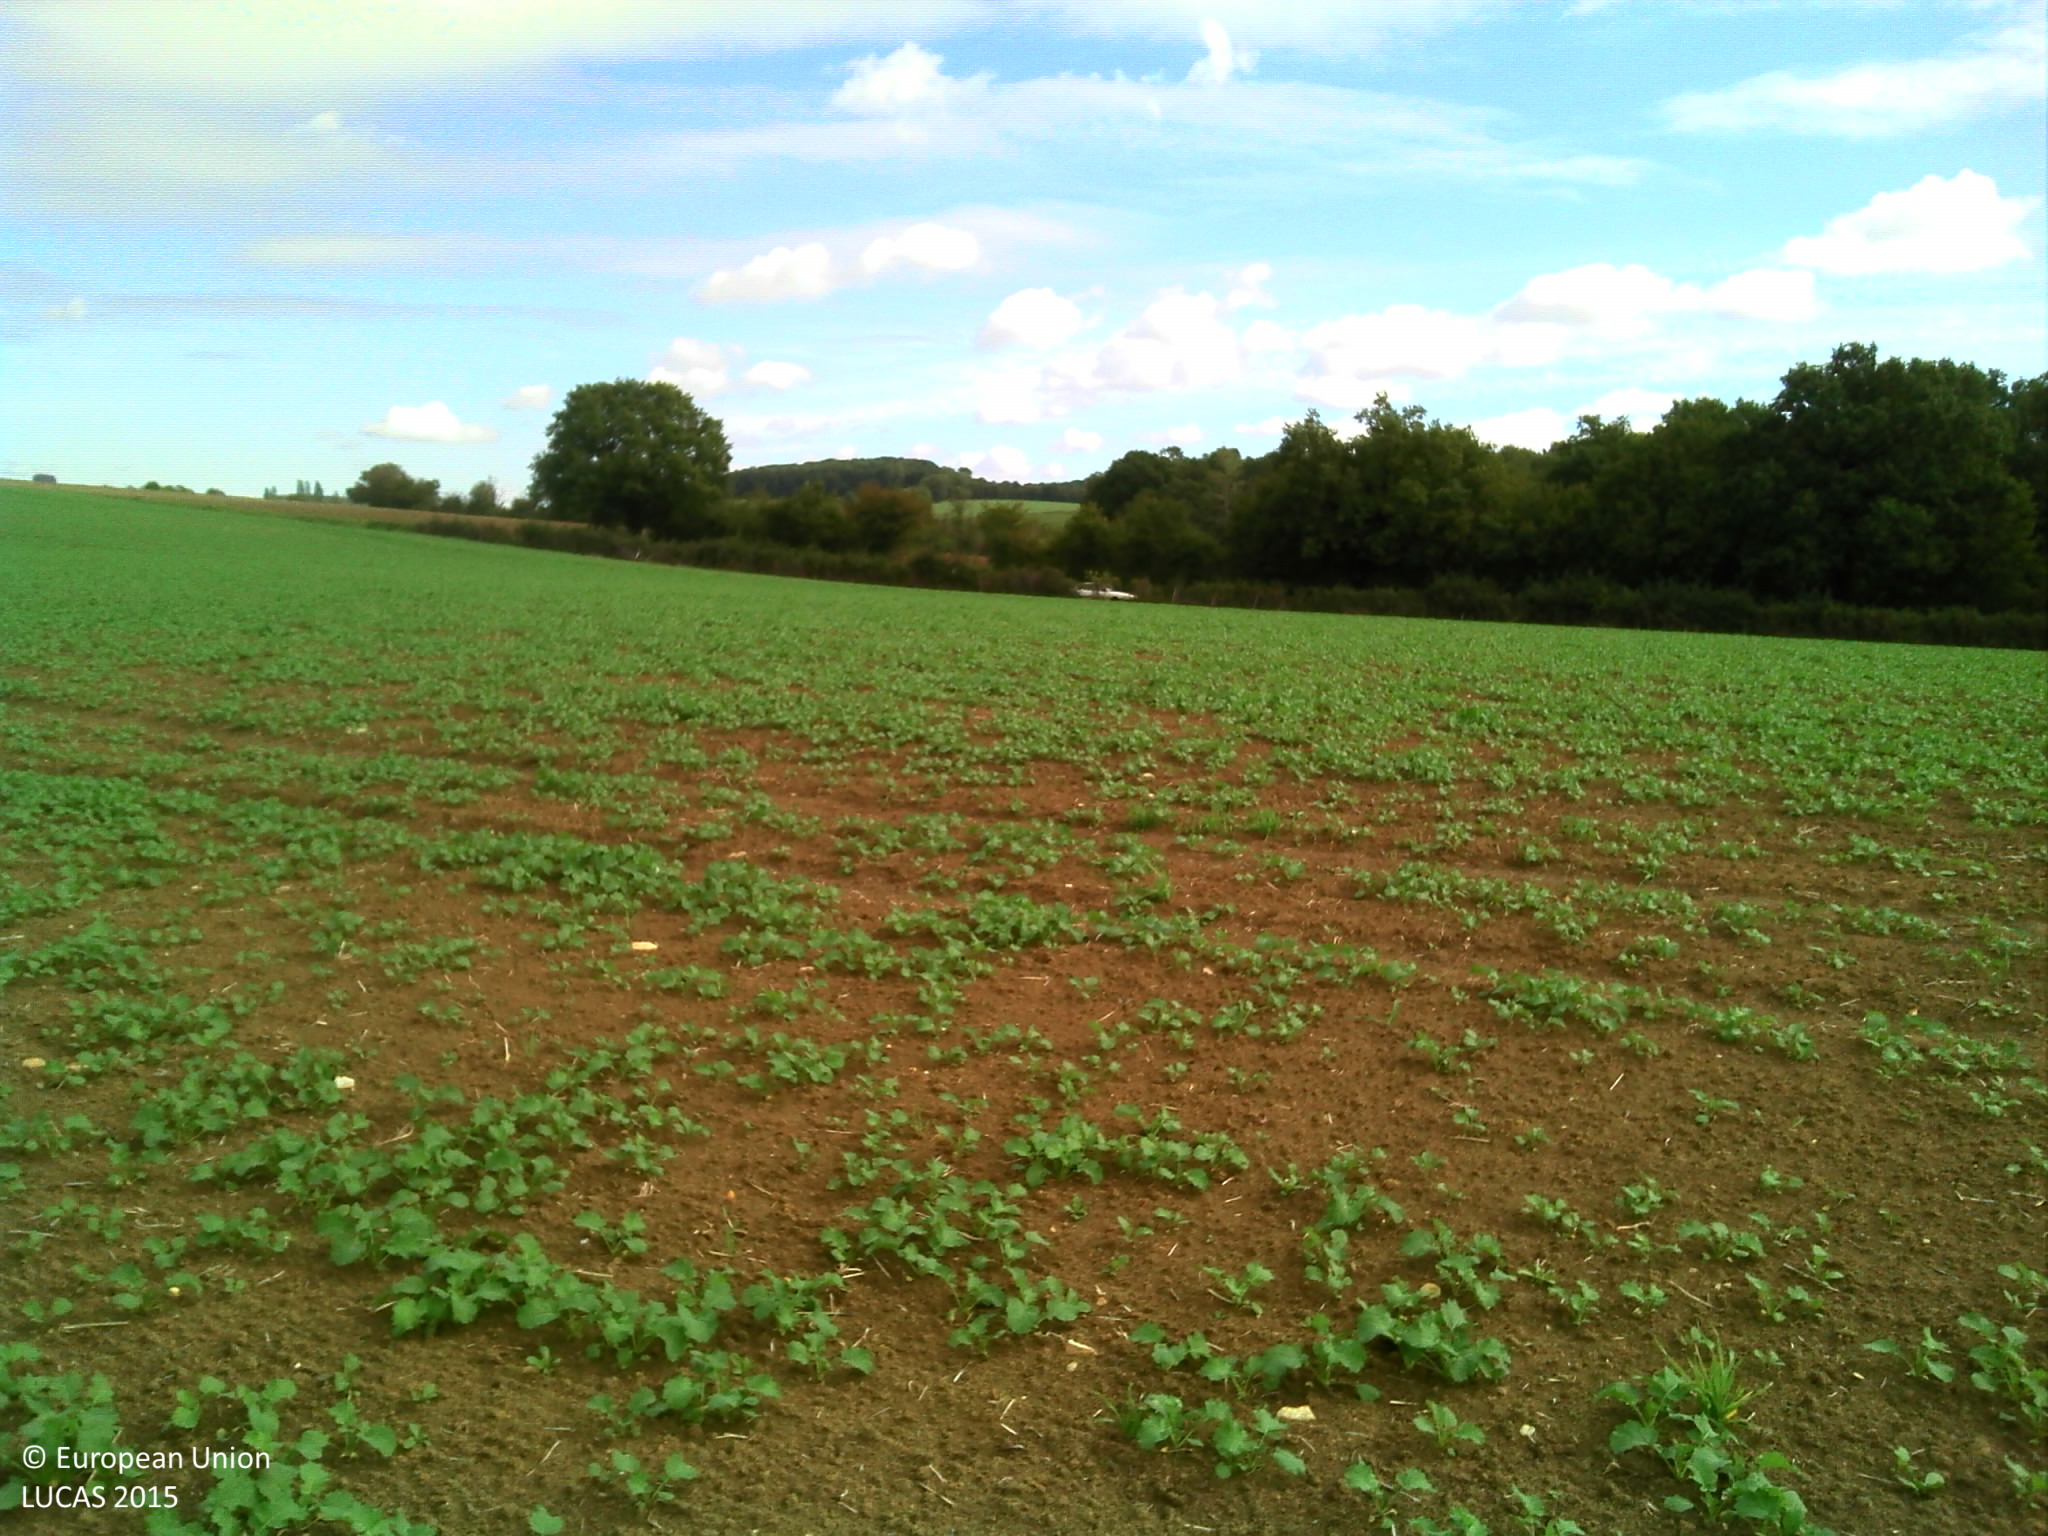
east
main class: Cropland
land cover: Rape and turnip rape
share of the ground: > 75 %
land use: Agriculture (excluding fallow land and kitchen gardens)
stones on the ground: < 10 %
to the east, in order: Rape and turnip rape; Managed hedges; Ditches and canals; Grass margins; Tracks; Grass margins; Ditches and canals; Broadleaved woodland; Fences; Grassland without tree/shrub cover; Fences; Common wheat
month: June
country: FR
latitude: 47.2326
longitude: 2.5832
